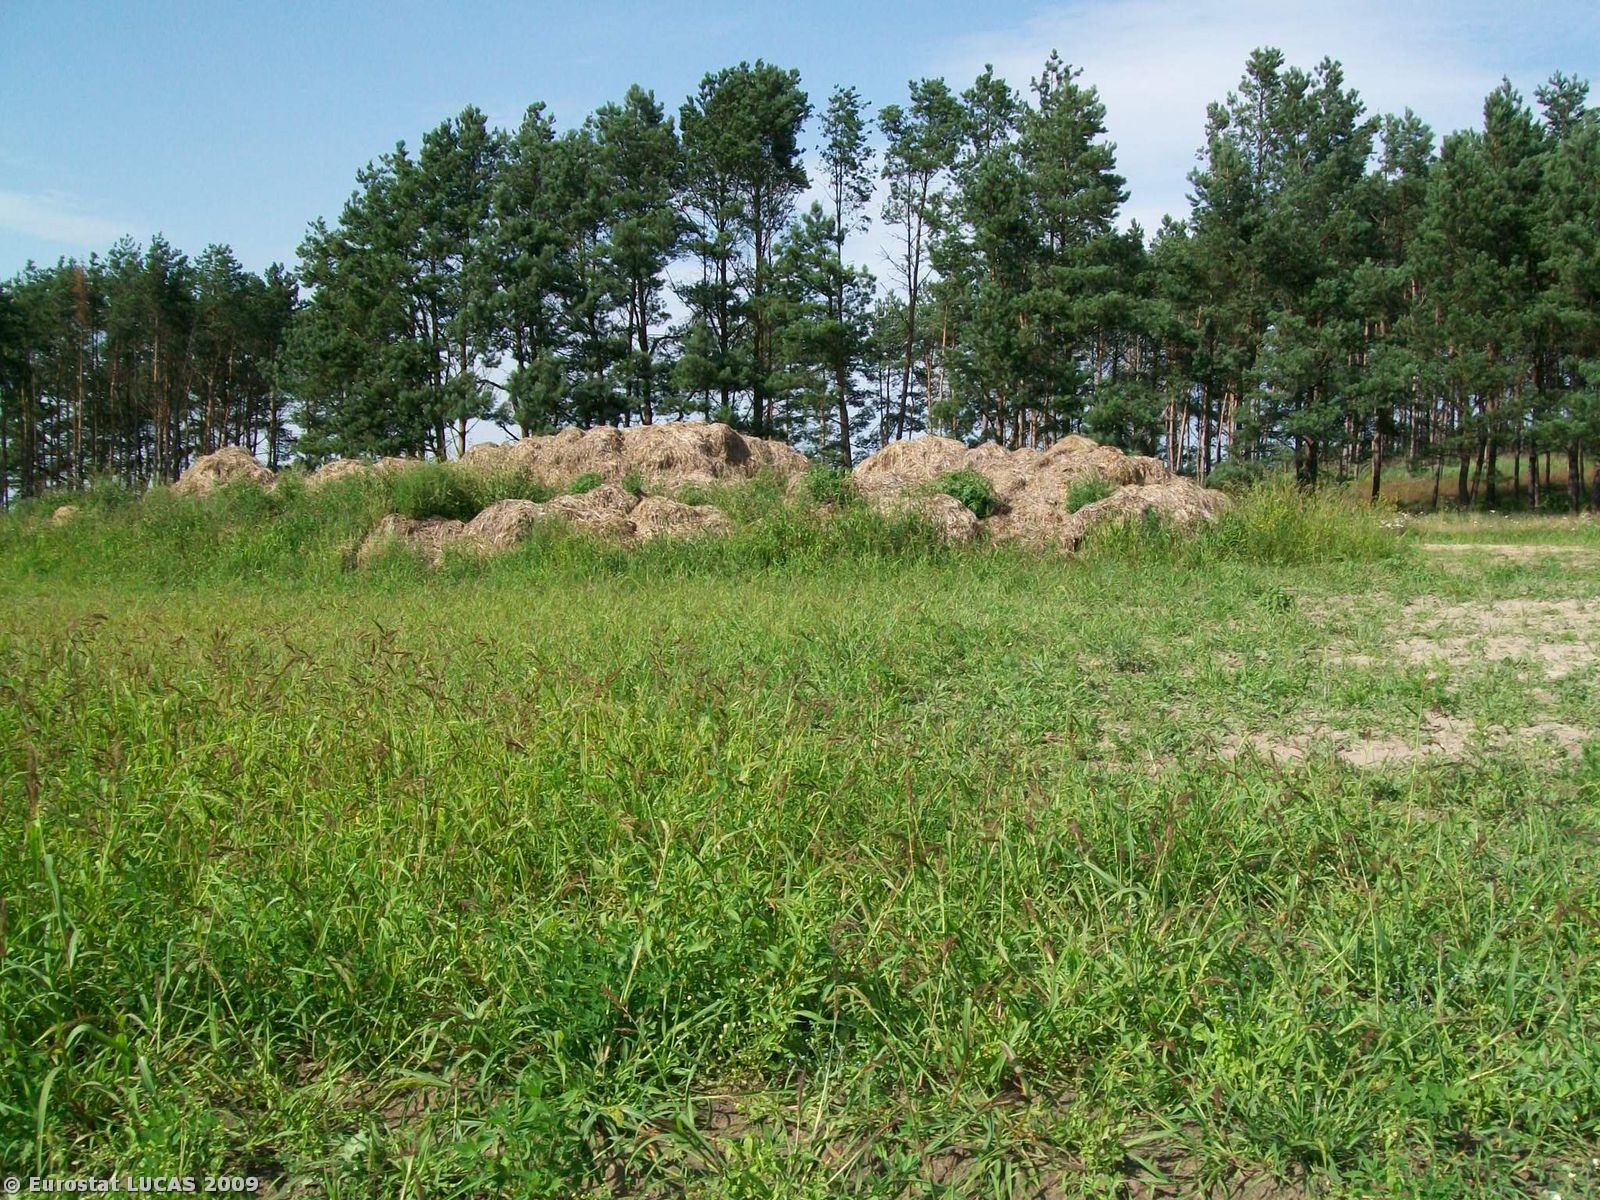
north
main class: Grassland
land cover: Spontaneously vegetated surfaces
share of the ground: > 75 %
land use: Fallow land
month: July
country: PL
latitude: 51.1425
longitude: 17.2871
